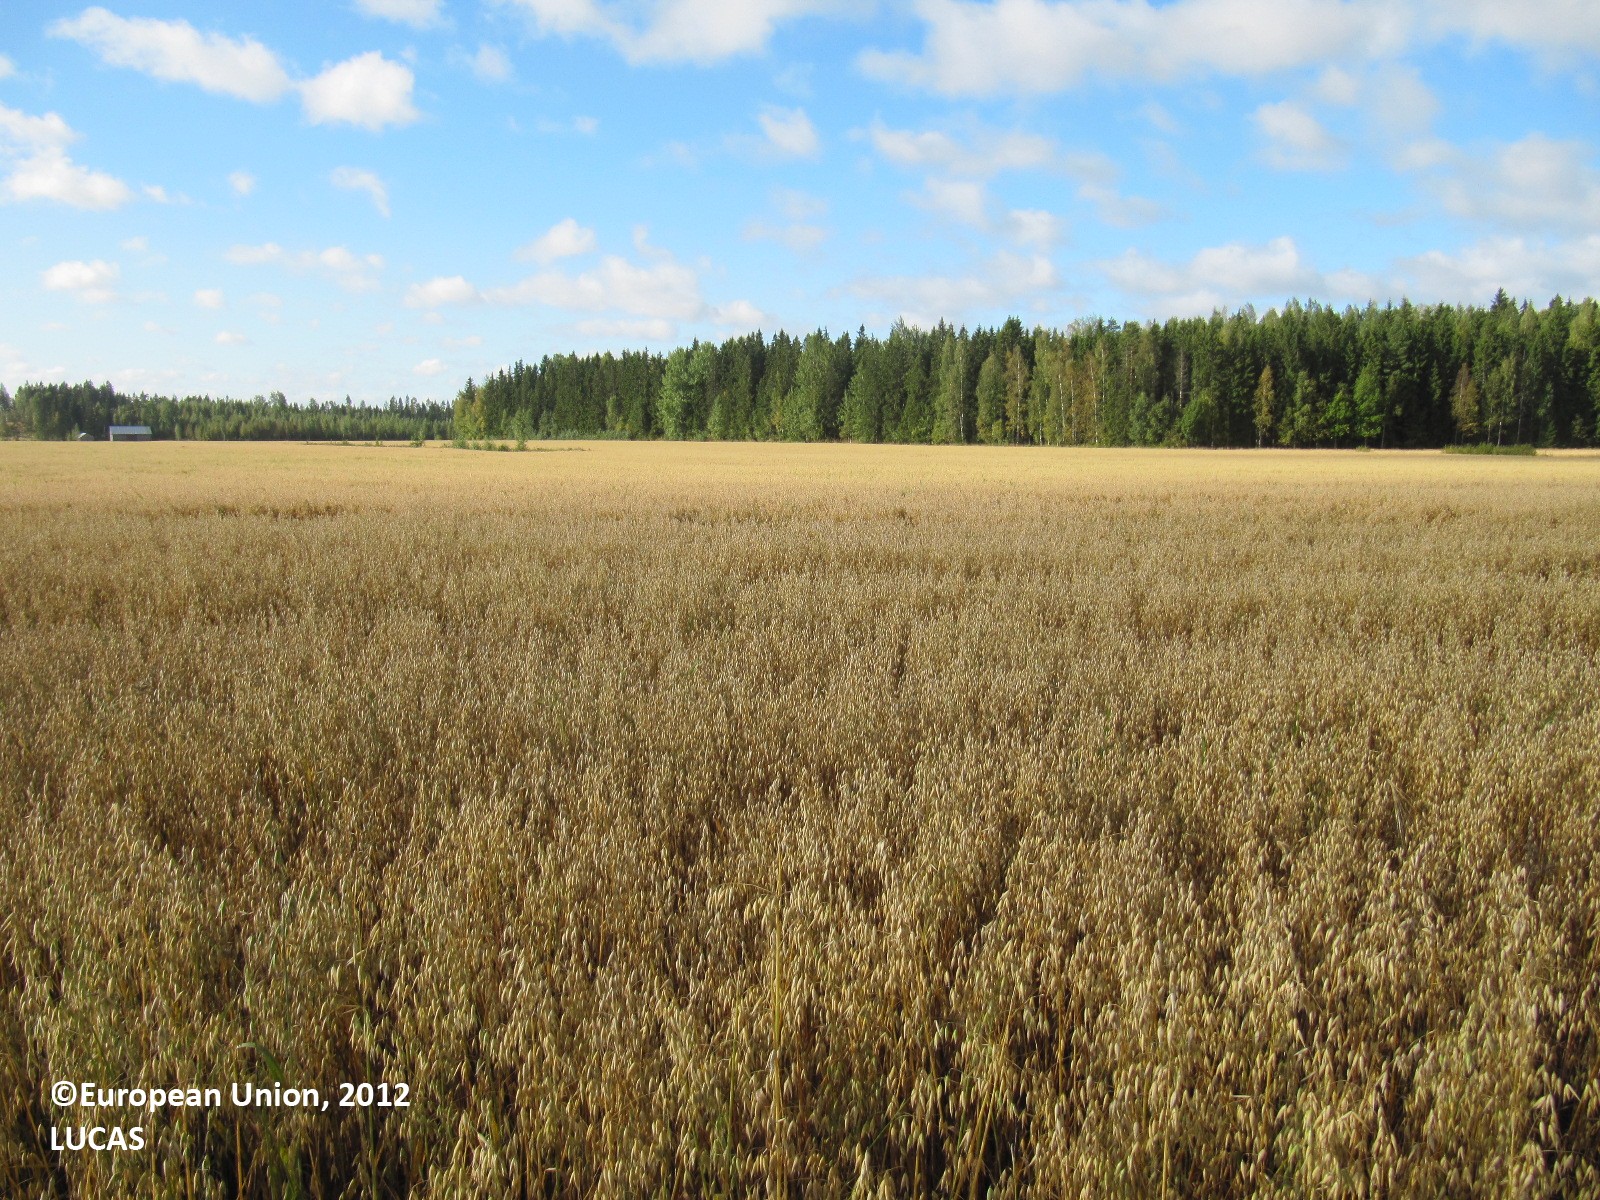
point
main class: Cropland
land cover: Oats
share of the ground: > 75 %
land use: Agriculture (excluding fallow land and kitchen gardens)
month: September
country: FI
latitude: 60.7606
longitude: 23.2394
